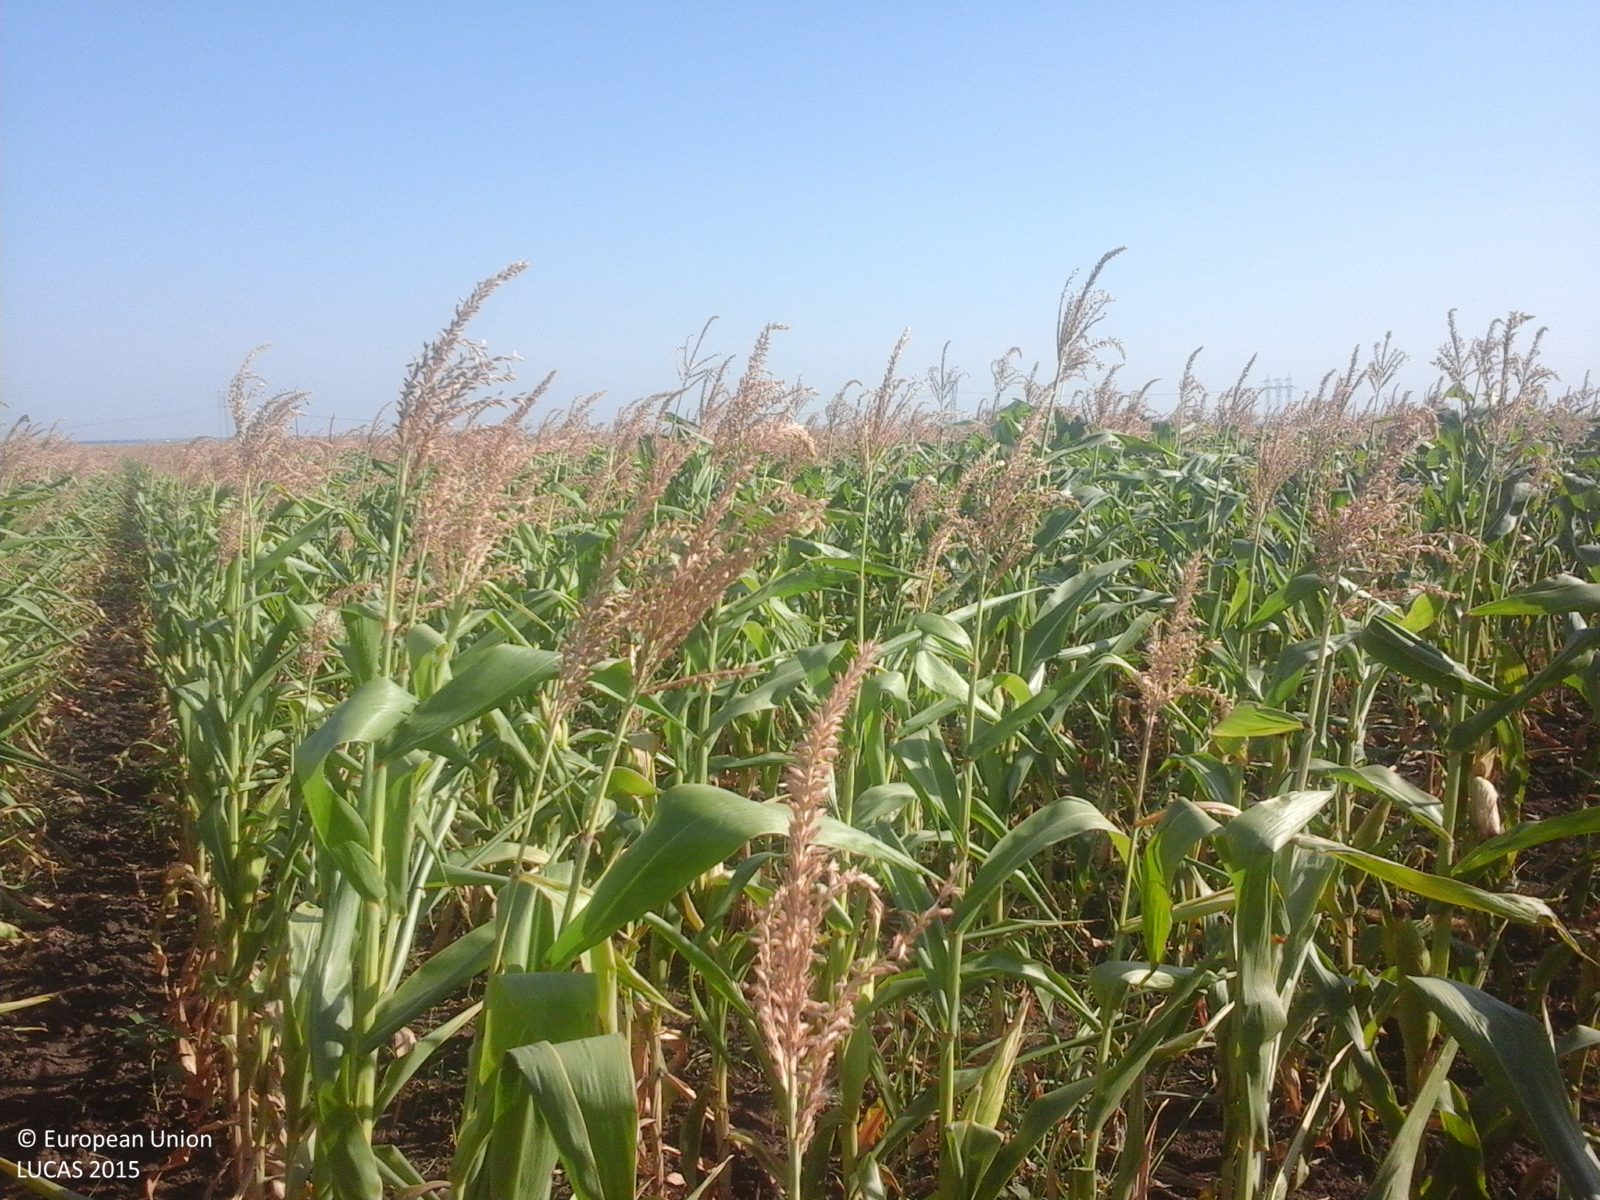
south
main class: Cropland
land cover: Maize
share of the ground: > 75 %
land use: Agriculture (excluding fallow land and kitchen gardens)
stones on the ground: < 10 %
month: August
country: RO
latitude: 45.0712
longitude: 26.6502
